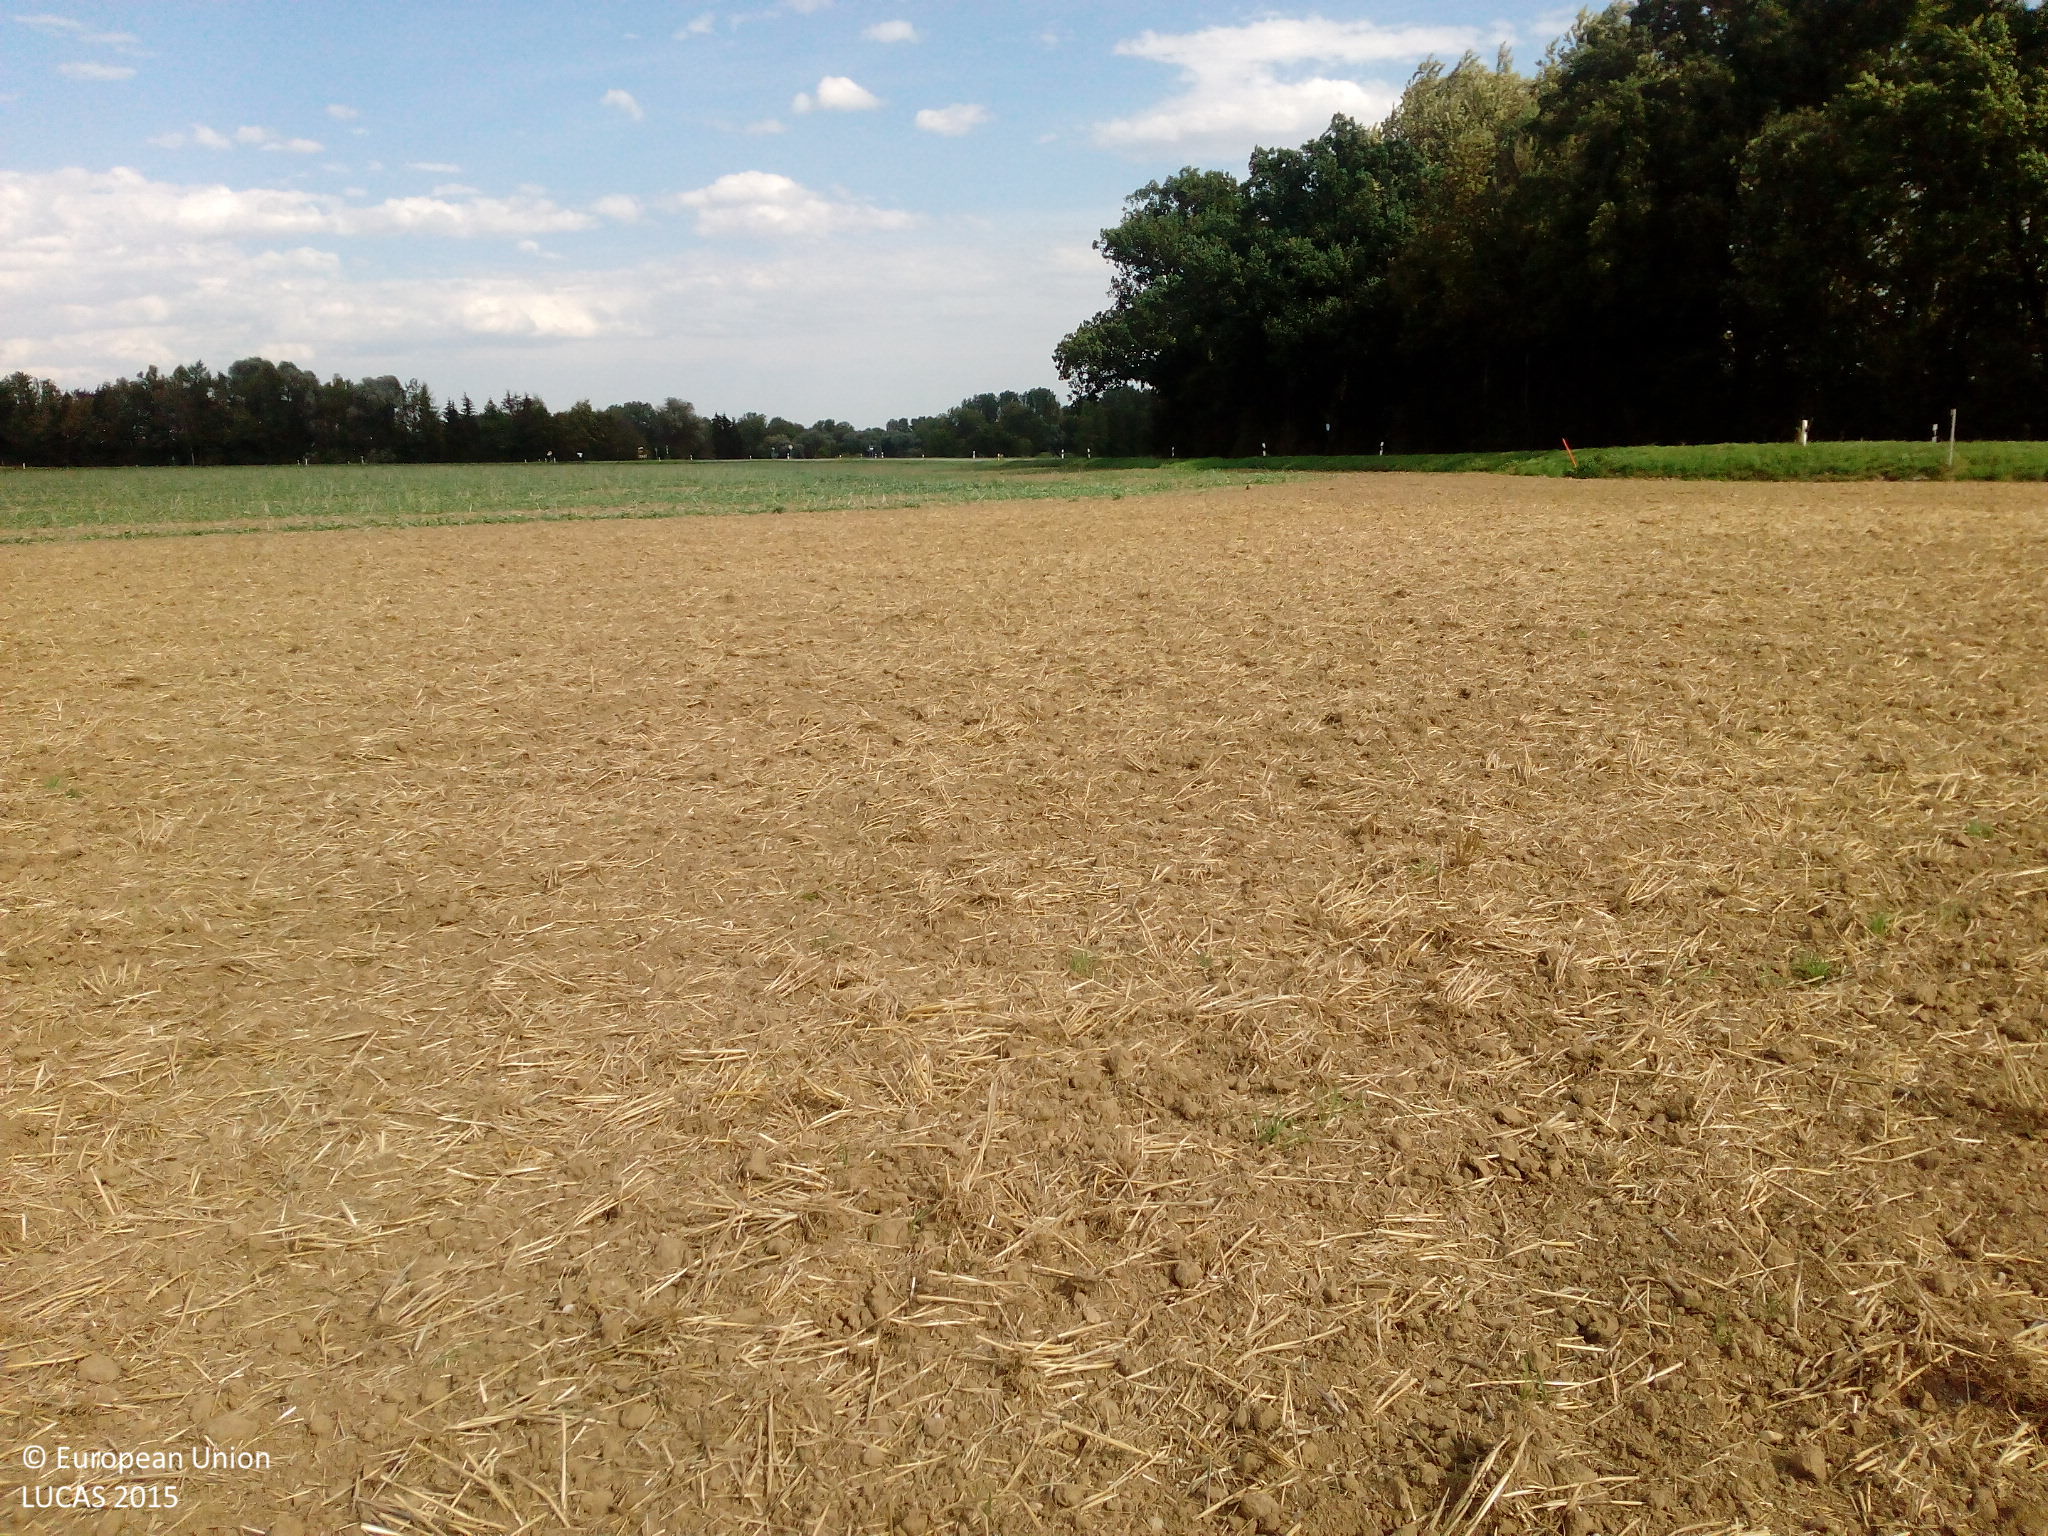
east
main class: Cropland
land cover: Common wheat
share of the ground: 10 - 25 %
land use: Agriculture (excluding fallow land and kitchen gardens)
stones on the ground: < 10 %
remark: Harvested field
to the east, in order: Common wheat; Rape and turnip rape; Grass margins; Paved roads, cycling and walking lanes; Grass margins; Spruce dominated mixed woodland; Broadleaved woodland; Grassland without tree/shrub cover; Broadleaved woodland
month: September
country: DE
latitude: 48.4770
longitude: 11.9066
